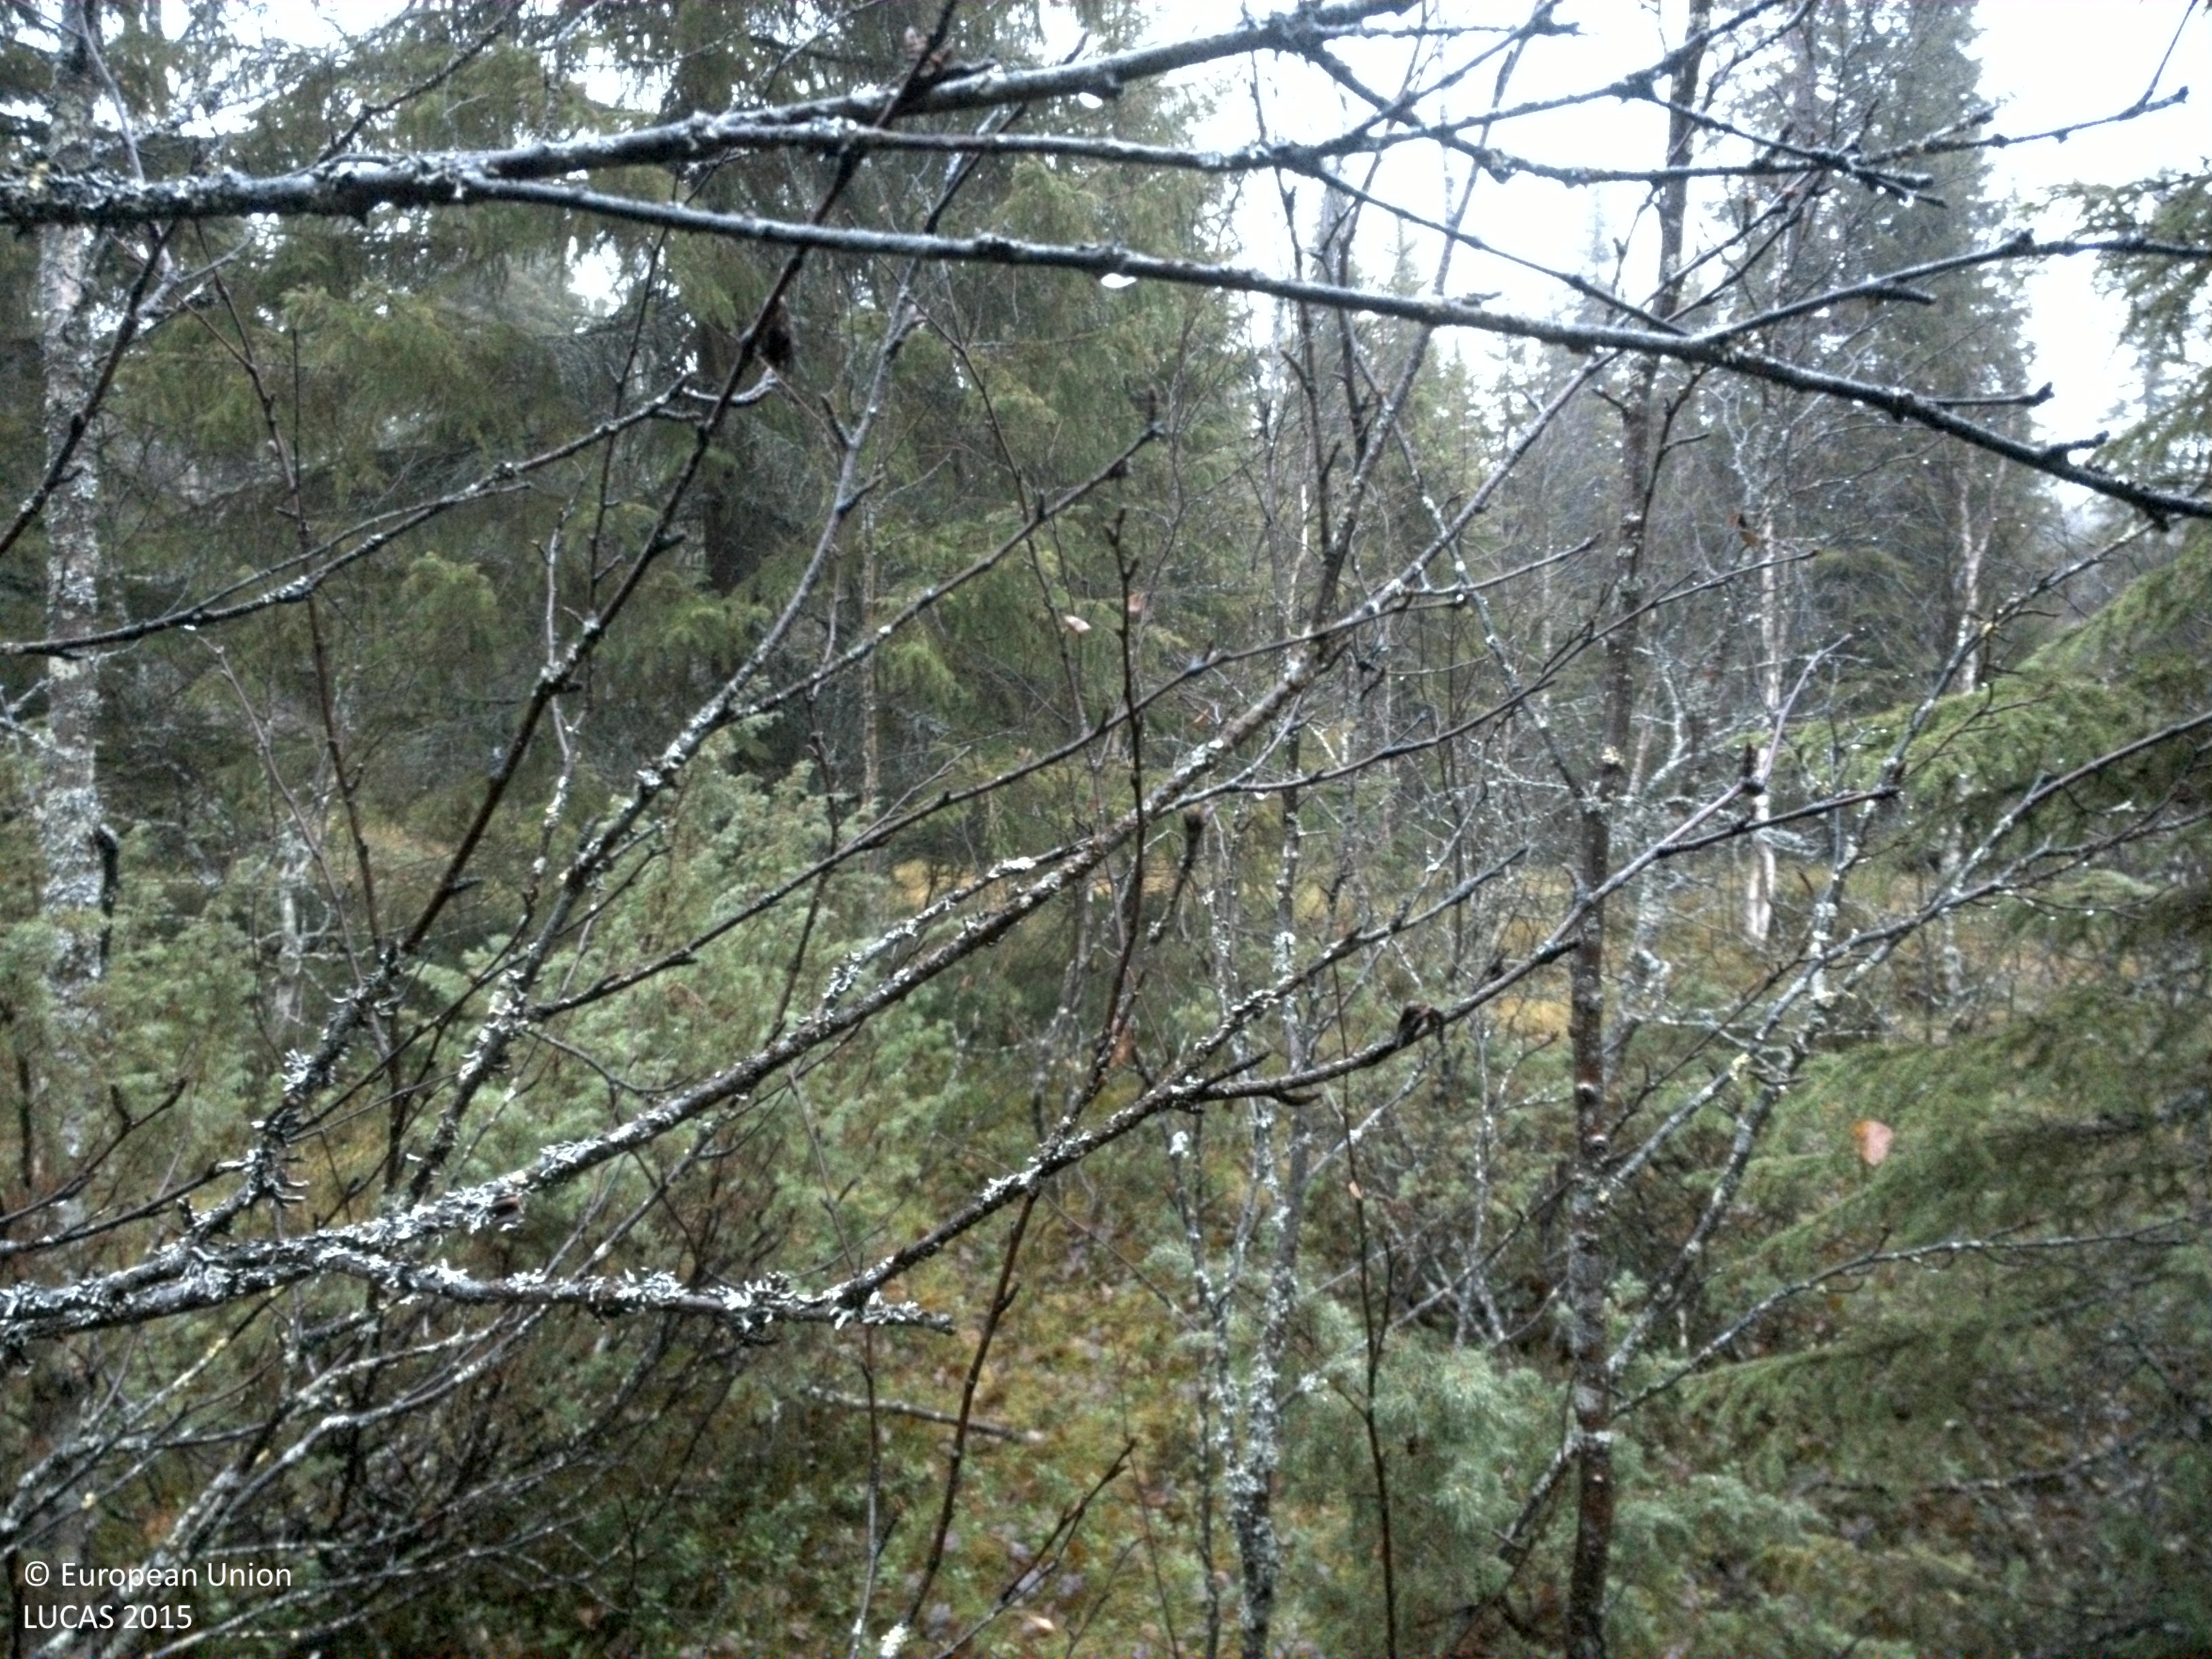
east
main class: Woodland
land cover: Spruce dominated mixed woodland
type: boreal forest
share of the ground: 25 - 50 %
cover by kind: shrubs 40 %, coniferous forest trees 30 %, broadleaved forest trees 15 %, herbaceous plants 10 %, lichens and mosses 5 %
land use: Forestry
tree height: > 5 m
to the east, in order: Spruce dominated mixed woodland; Spruce dominated coniferous woodland
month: October
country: SE
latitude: 64.5118
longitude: 17.4858
